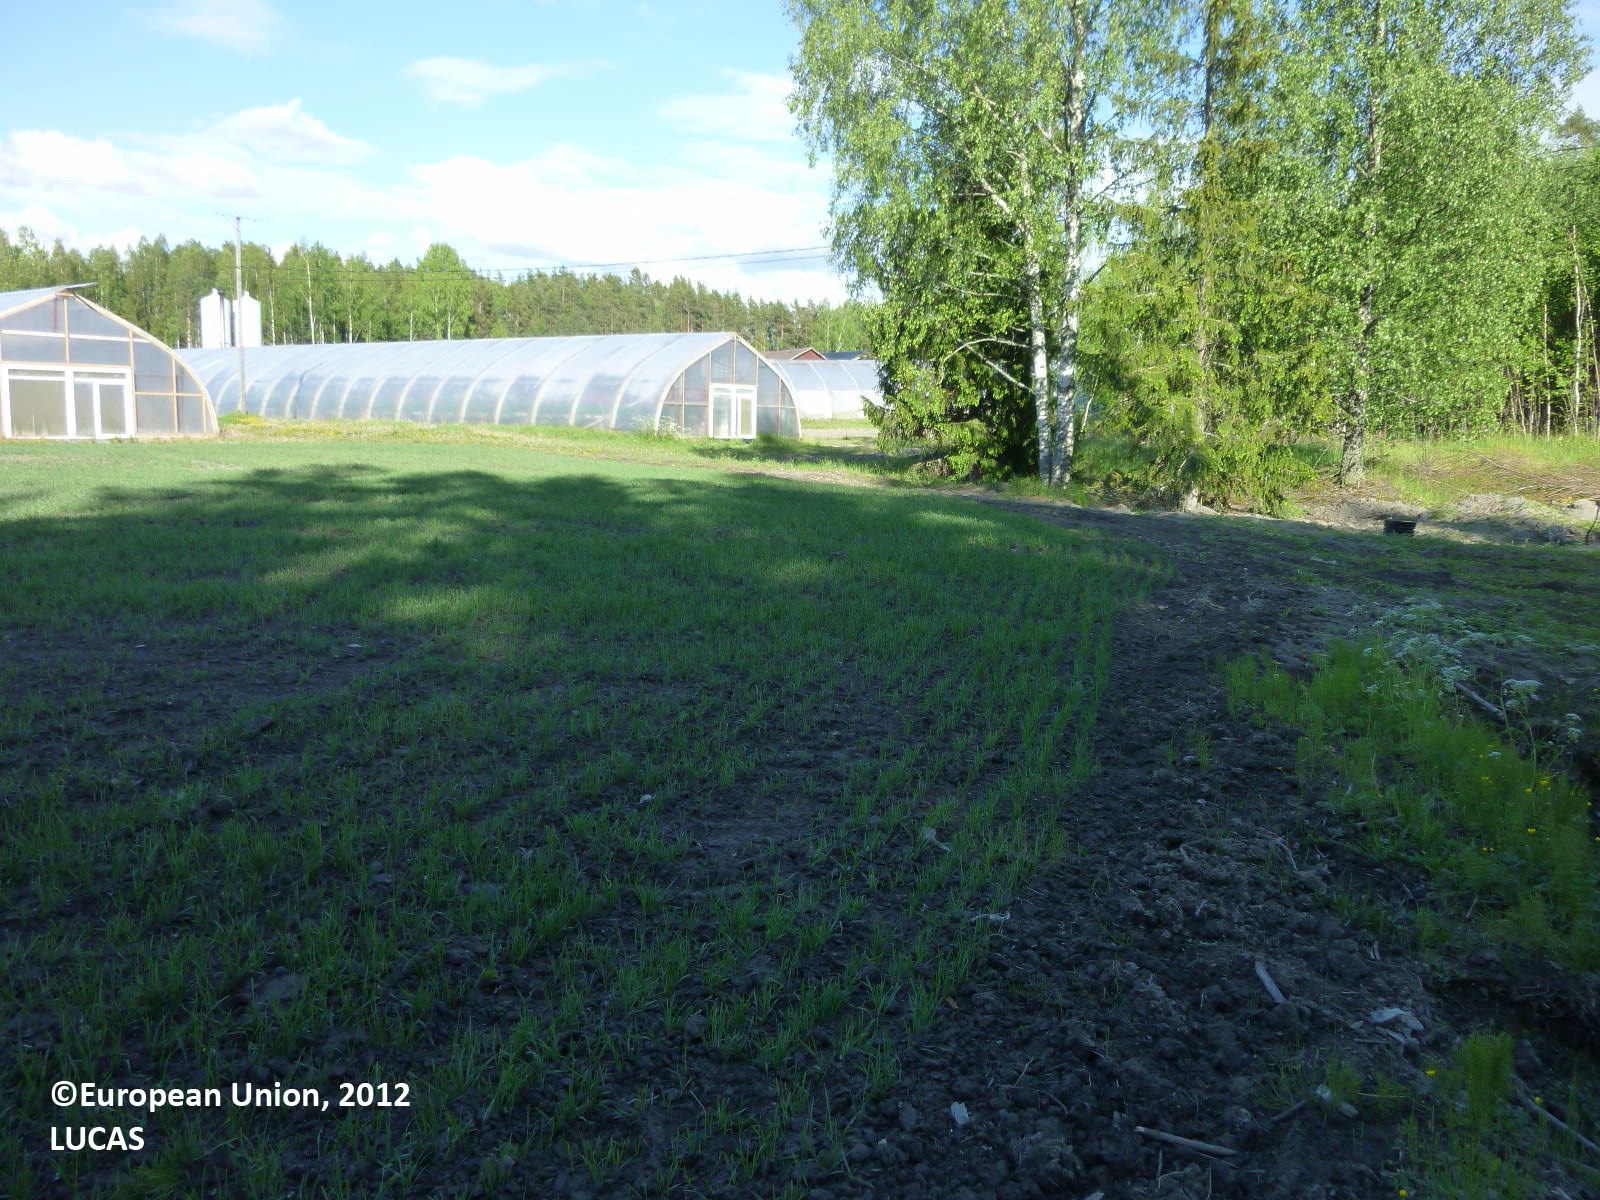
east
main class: Cropland
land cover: Common wheat
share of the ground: > 75 %
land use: Agriculture (excluding fallow land and kitchen gardens)
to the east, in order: Common wheat; Grassland without tree/shrub cover; Artificial constructions in urban areas; Pine dominated coniferous woodland
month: June
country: FI
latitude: 60.3377
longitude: 22.6637
